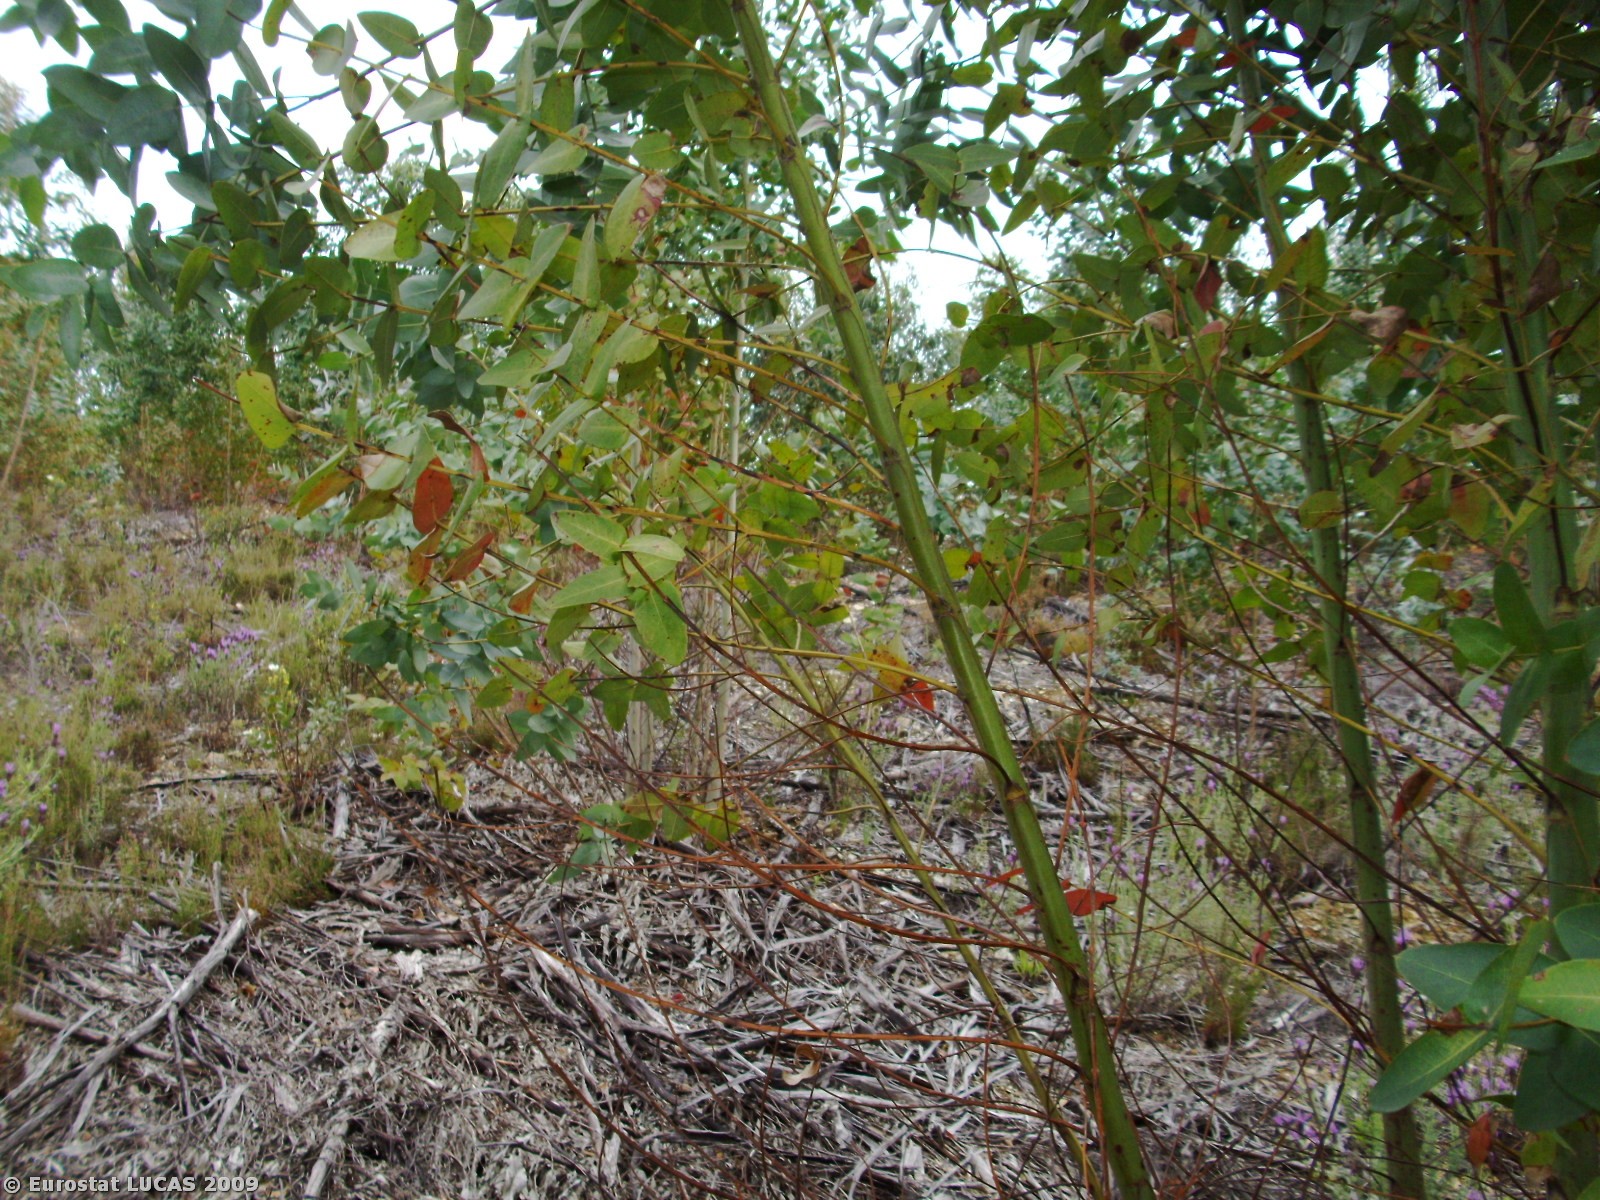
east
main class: Woodland
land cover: Broadleaved woodland
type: plantations and self-sown exotic forest
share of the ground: > 75 %
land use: Forestry
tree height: > 5 m
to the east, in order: Broadleaved woodland; Tracks; Broadleaved woodland; Tracks; Broadleaved woodland
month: April
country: PT
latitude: 39.7731
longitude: -7.4815
